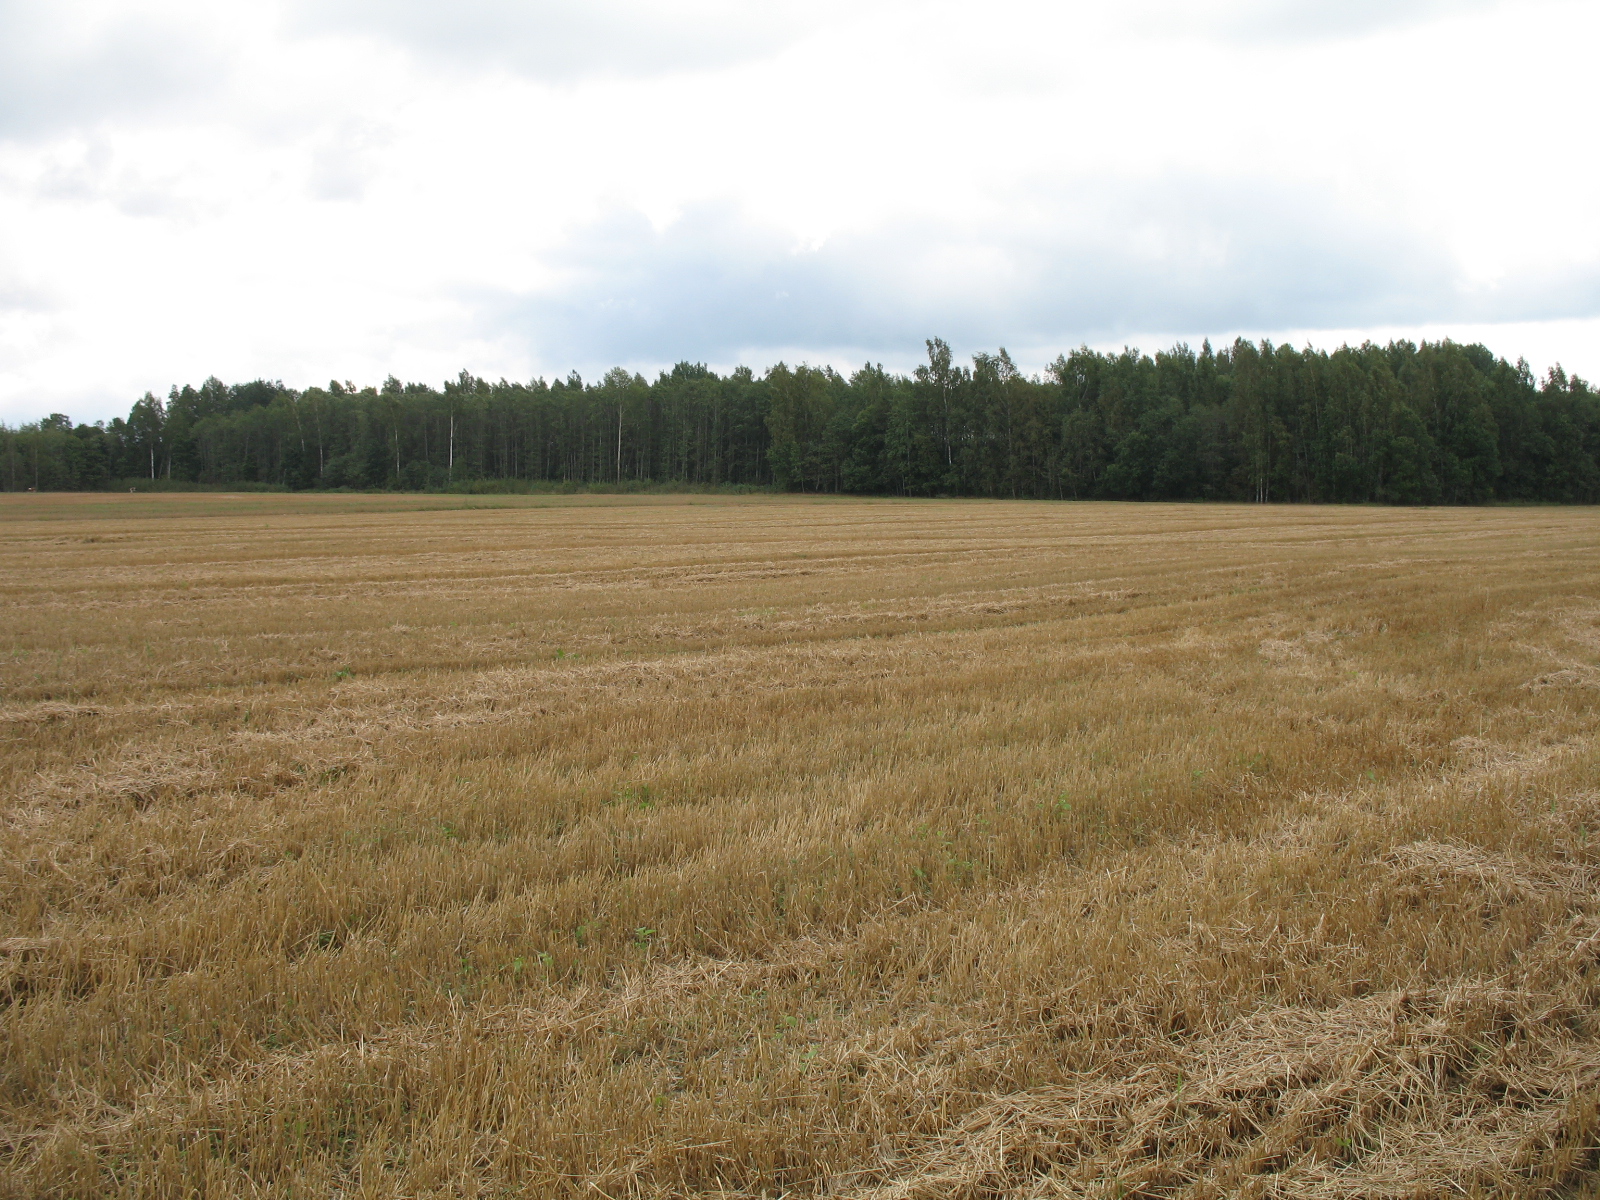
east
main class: Cropland
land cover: Barley
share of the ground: < 10 %
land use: Agriculture (excluding fallow land and kitchen gardens)
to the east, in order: Barley; Common wheat
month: September
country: LV
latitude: 56.1880
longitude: 25.9735
